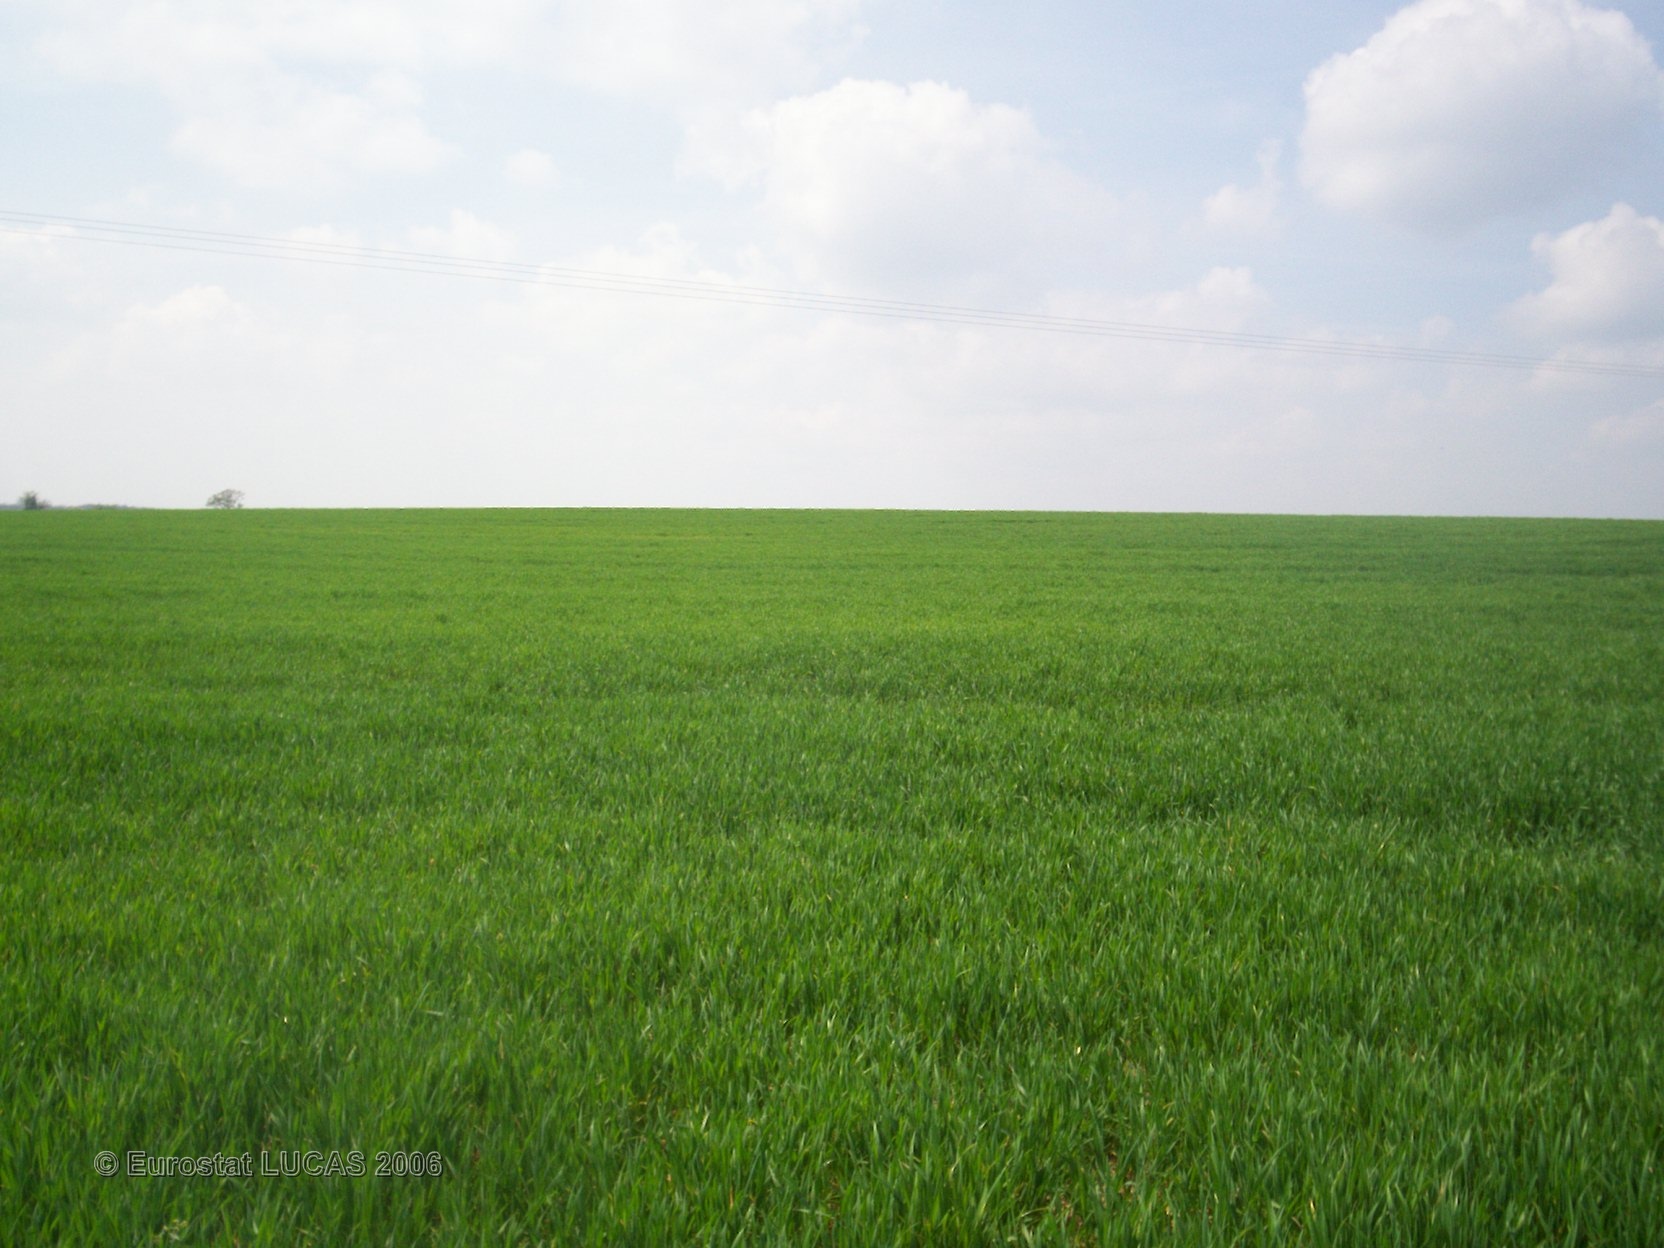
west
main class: Cropland
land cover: Common wheat
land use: Agriculture (excluding fallow land and kitchen gardens)
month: April
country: FR
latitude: 47.8382
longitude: 0.8008
